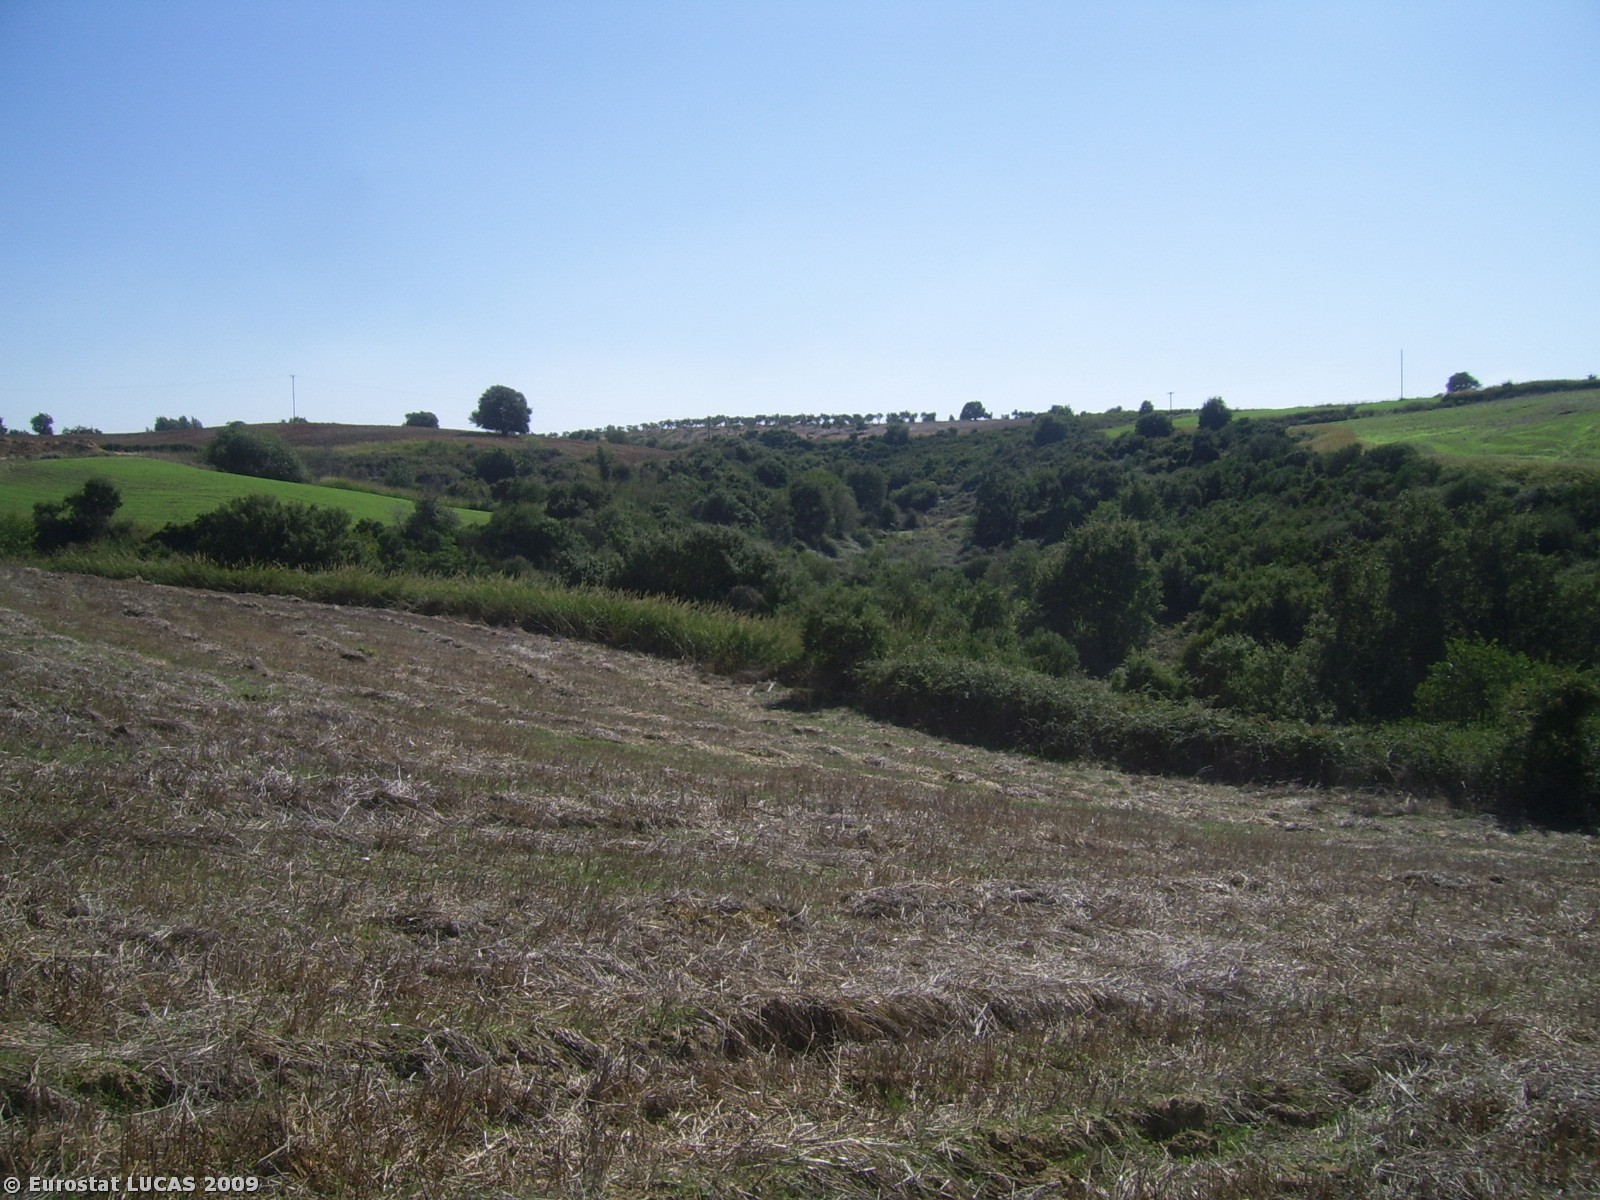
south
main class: Grassland
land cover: Grassland without tree/shrub cover
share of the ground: > 75 %
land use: Agriculture (excluding fallow land and kitchen gardens)
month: October
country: GR
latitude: 37.9408
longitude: 21.3746
